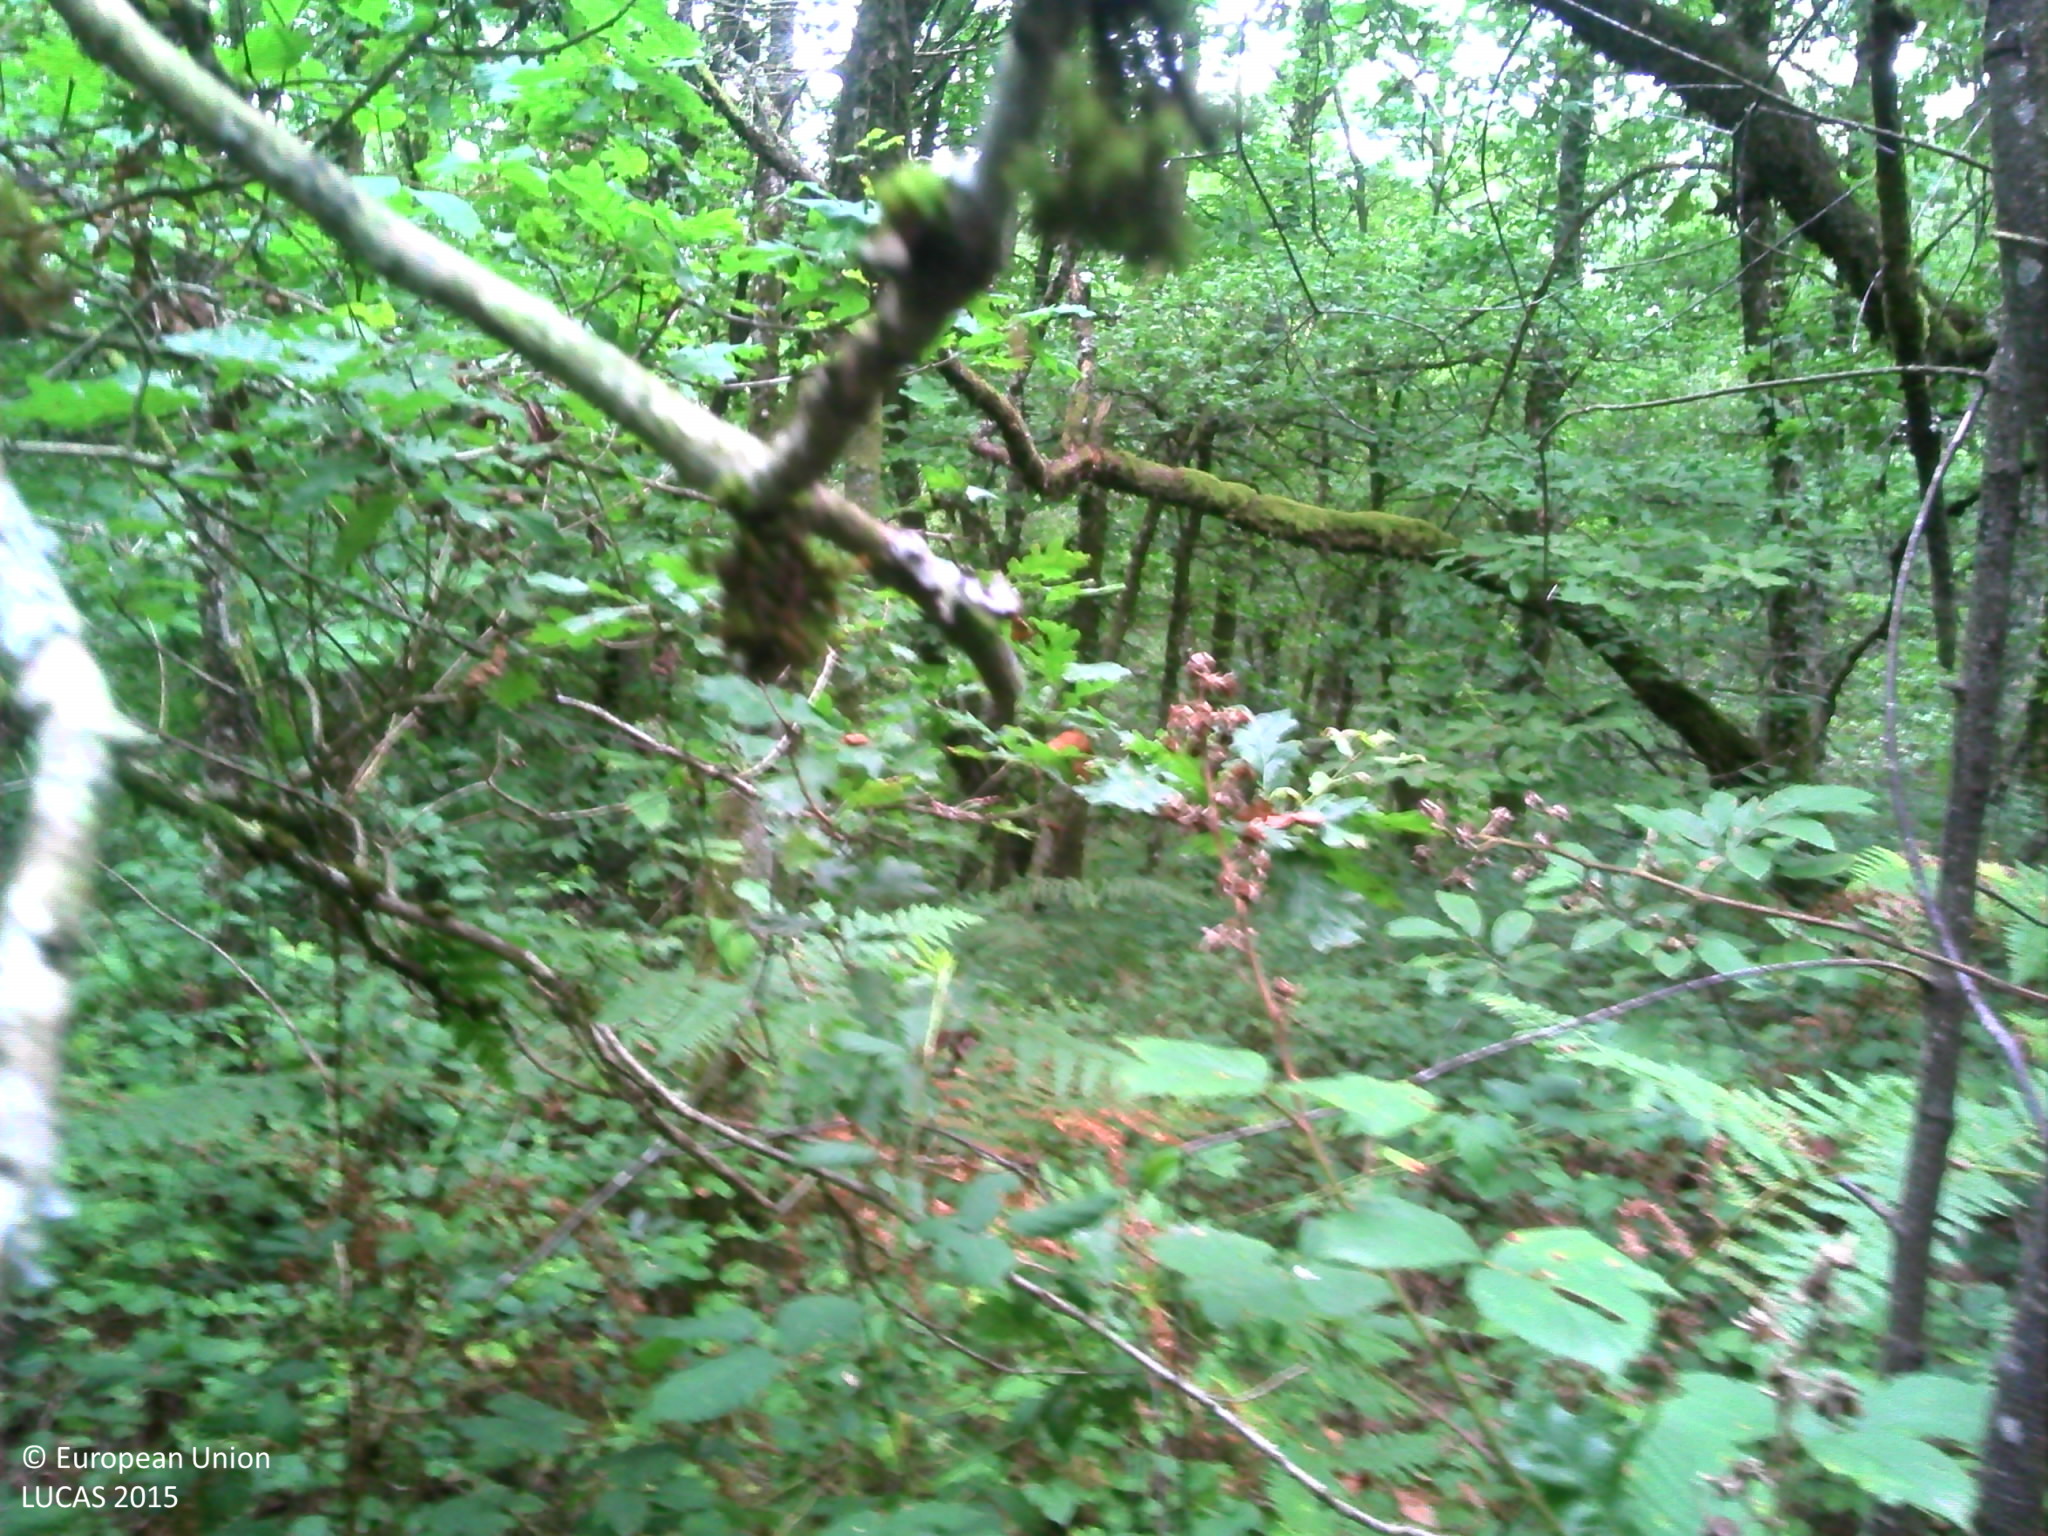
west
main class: Woodland
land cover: Broadleaved woodland
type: mesophytic deciduous forest
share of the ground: > 75 %
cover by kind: broadleaved forest trees 85 %, herbaceous plants 15 %
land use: Forestry
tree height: > 5 m
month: August
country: FR
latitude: 46.0404
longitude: 1.3978
